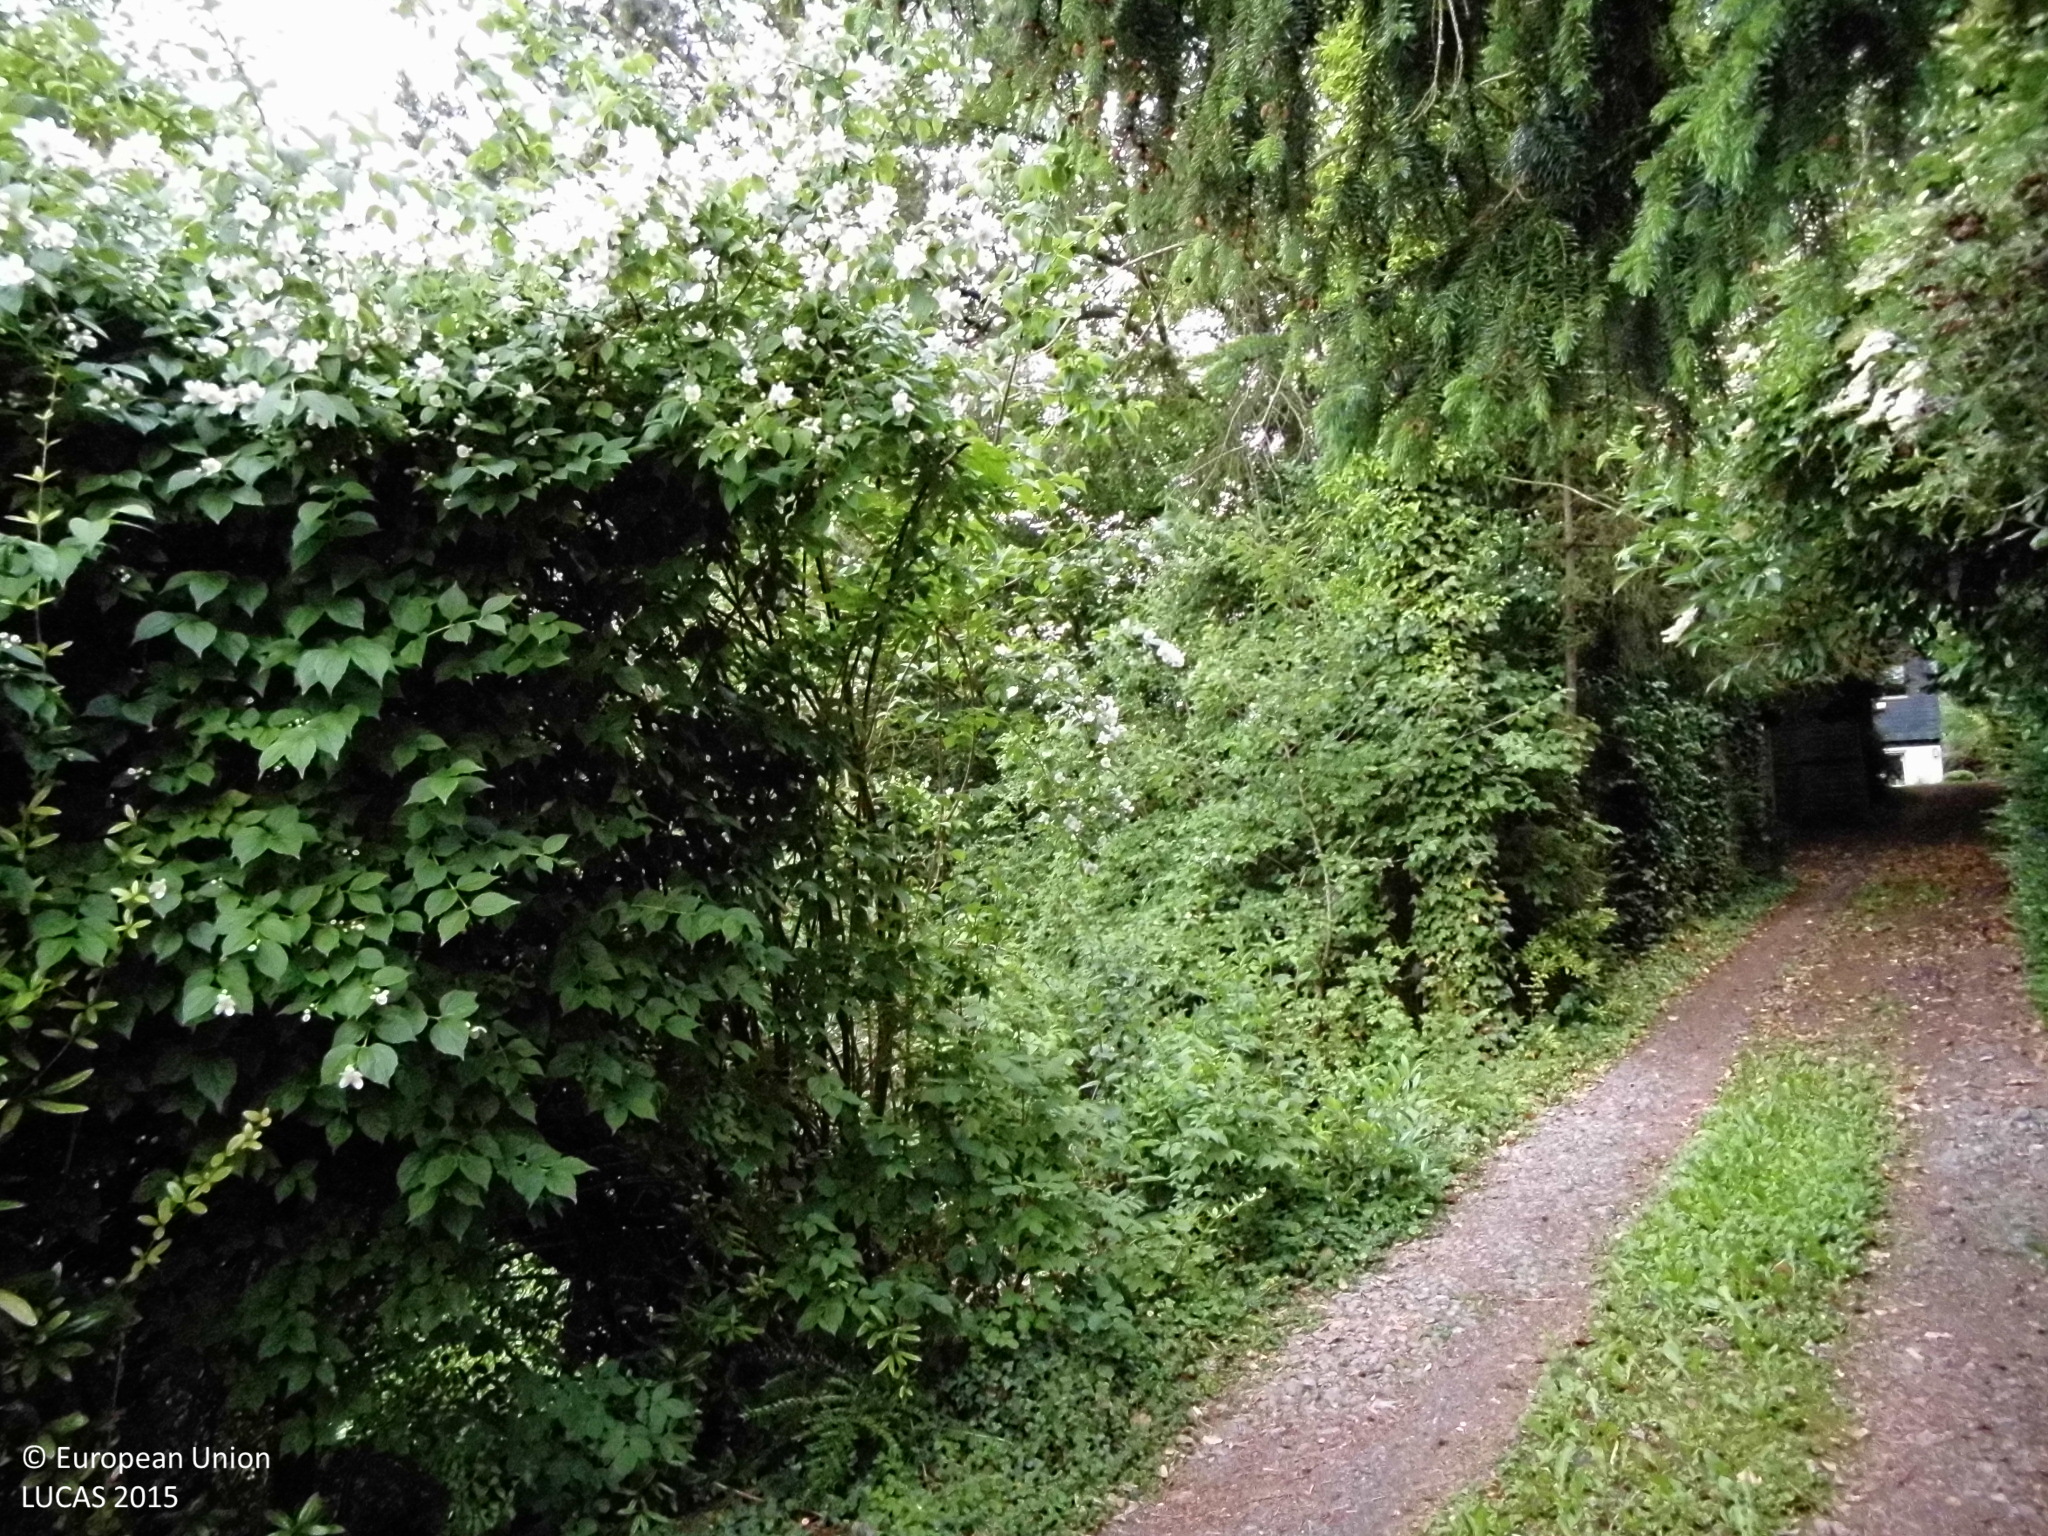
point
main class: Woodland
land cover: Other coniferous woodland
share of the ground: > 75 %
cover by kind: coniferous forest trees 70 %, broadleaved forest trees 20 %, shrubs 5 %, herbaceous plants 5 %
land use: Residential
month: June
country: DE
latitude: 51.3438
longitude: 7.4879
